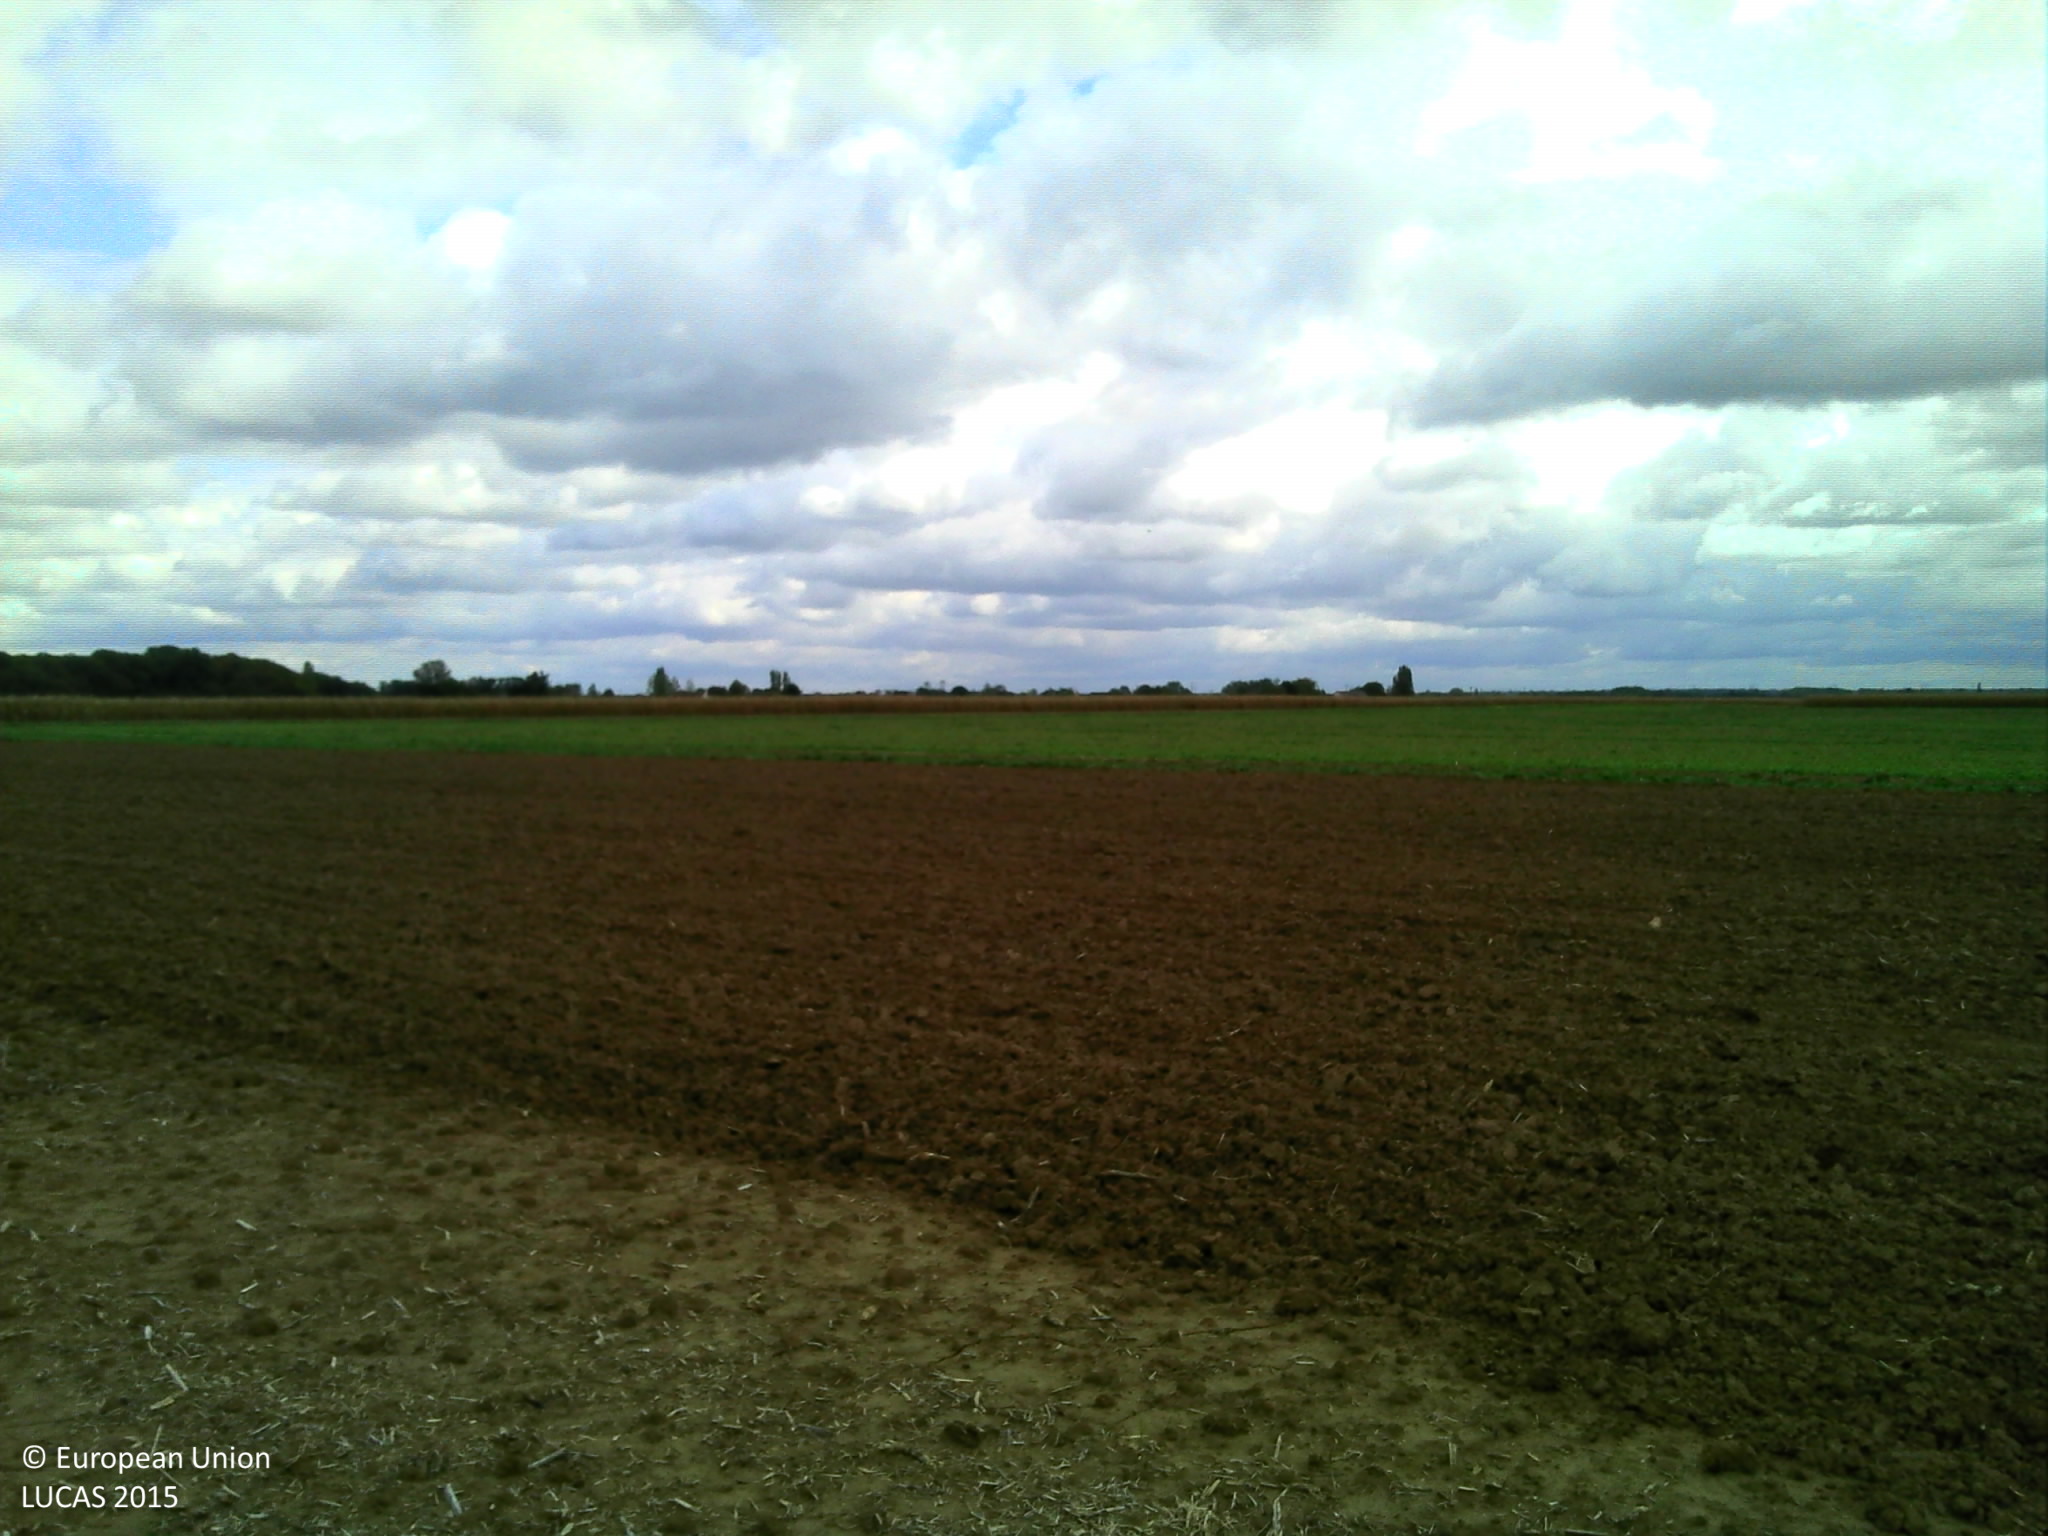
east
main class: Cropland
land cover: Rape and turnip rape
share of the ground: < 10 %
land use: Agriculture (excluding fallow land and kitchen gardens)
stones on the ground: < 10 %
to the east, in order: Rape and turnip rape; Other bare soil; Rape and turnip rape; Grass margins; Tracks; Grass margins; Other bare soil; Maize
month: September
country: FR
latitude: 47.0072
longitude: 4.9371
